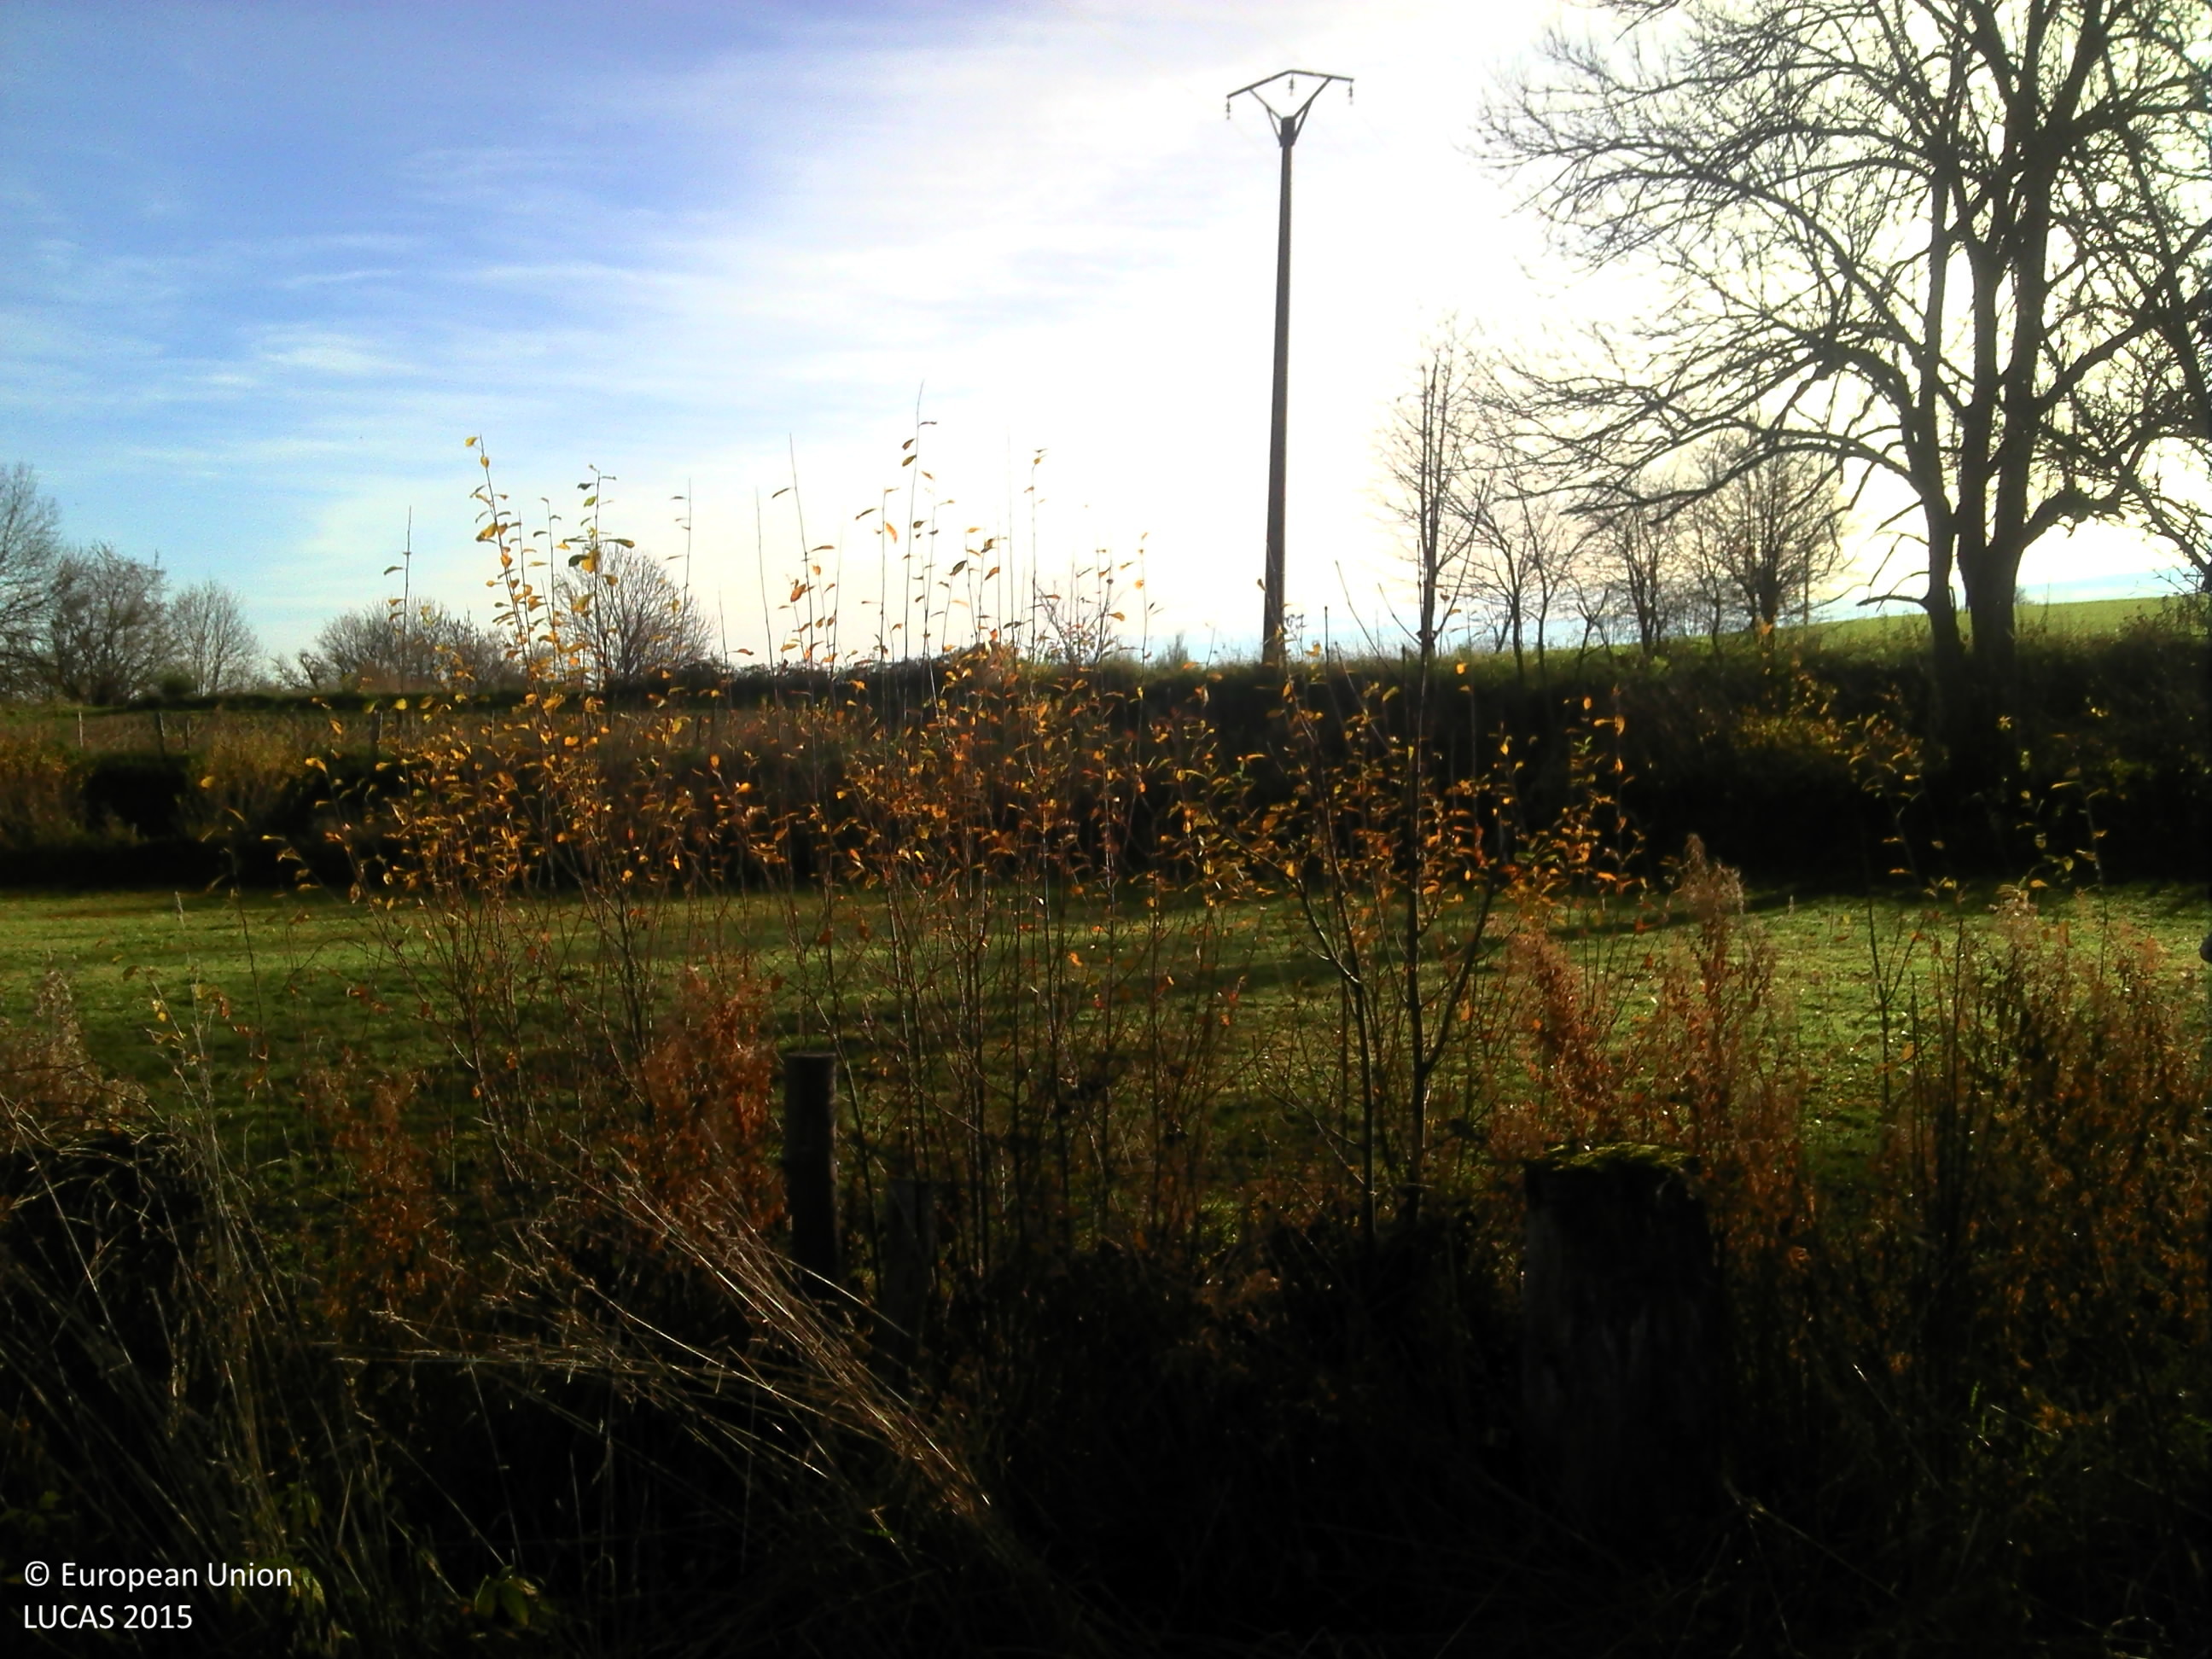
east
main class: Grassland
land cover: Grassland without tree/shrub cover
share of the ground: > 75 %
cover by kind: herbaceous plants 100 %
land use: Agriculture (excluding fallow land and kitchen gardens)
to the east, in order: Grassland without tree/shrub cover; Abandoned hedges; Fences; Abandoned hedges; Grassland without tree/shrub cover; Fences; Abandoned hedges; Grass margins; Tracks; Electric lines; Grass margins; Fences; Grass margins; Other bare soil; Grass margins; Dry stone walls; Abandoned hedges; Other bare soil; Abandoned hedges; Grass margins; Tracks; Grass margins; Abandoned hedges; Fences; Grassland without tree/shrub cover; Artificial constructions in urban areas
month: November
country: FR
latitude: 45.3246
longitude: 3.8410
